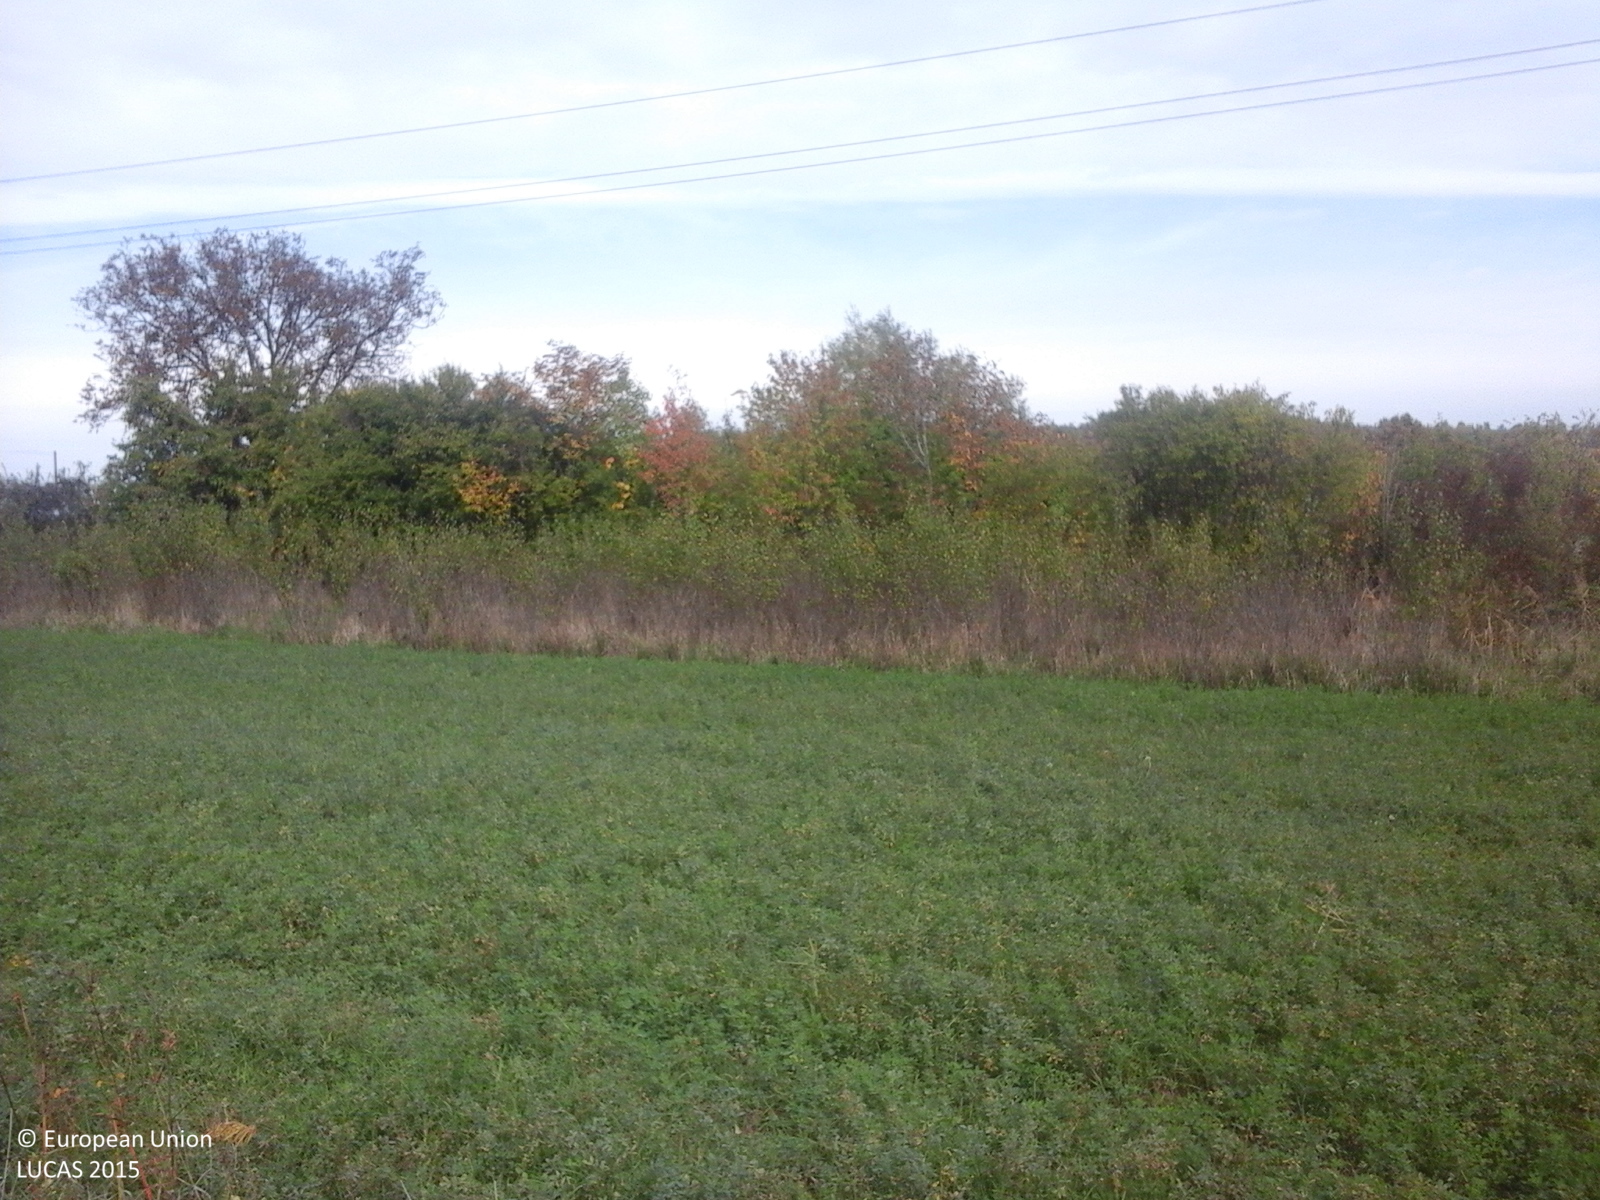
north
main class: Grassland
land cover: Spontaneously vegetated surfaces
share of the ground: > 75 %
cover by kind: herbaceous plants 100 %
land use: Agriculture (excluding fallow land and kitchen gardens)
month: October
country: RO
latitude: 44.9388
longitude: 25.4927
